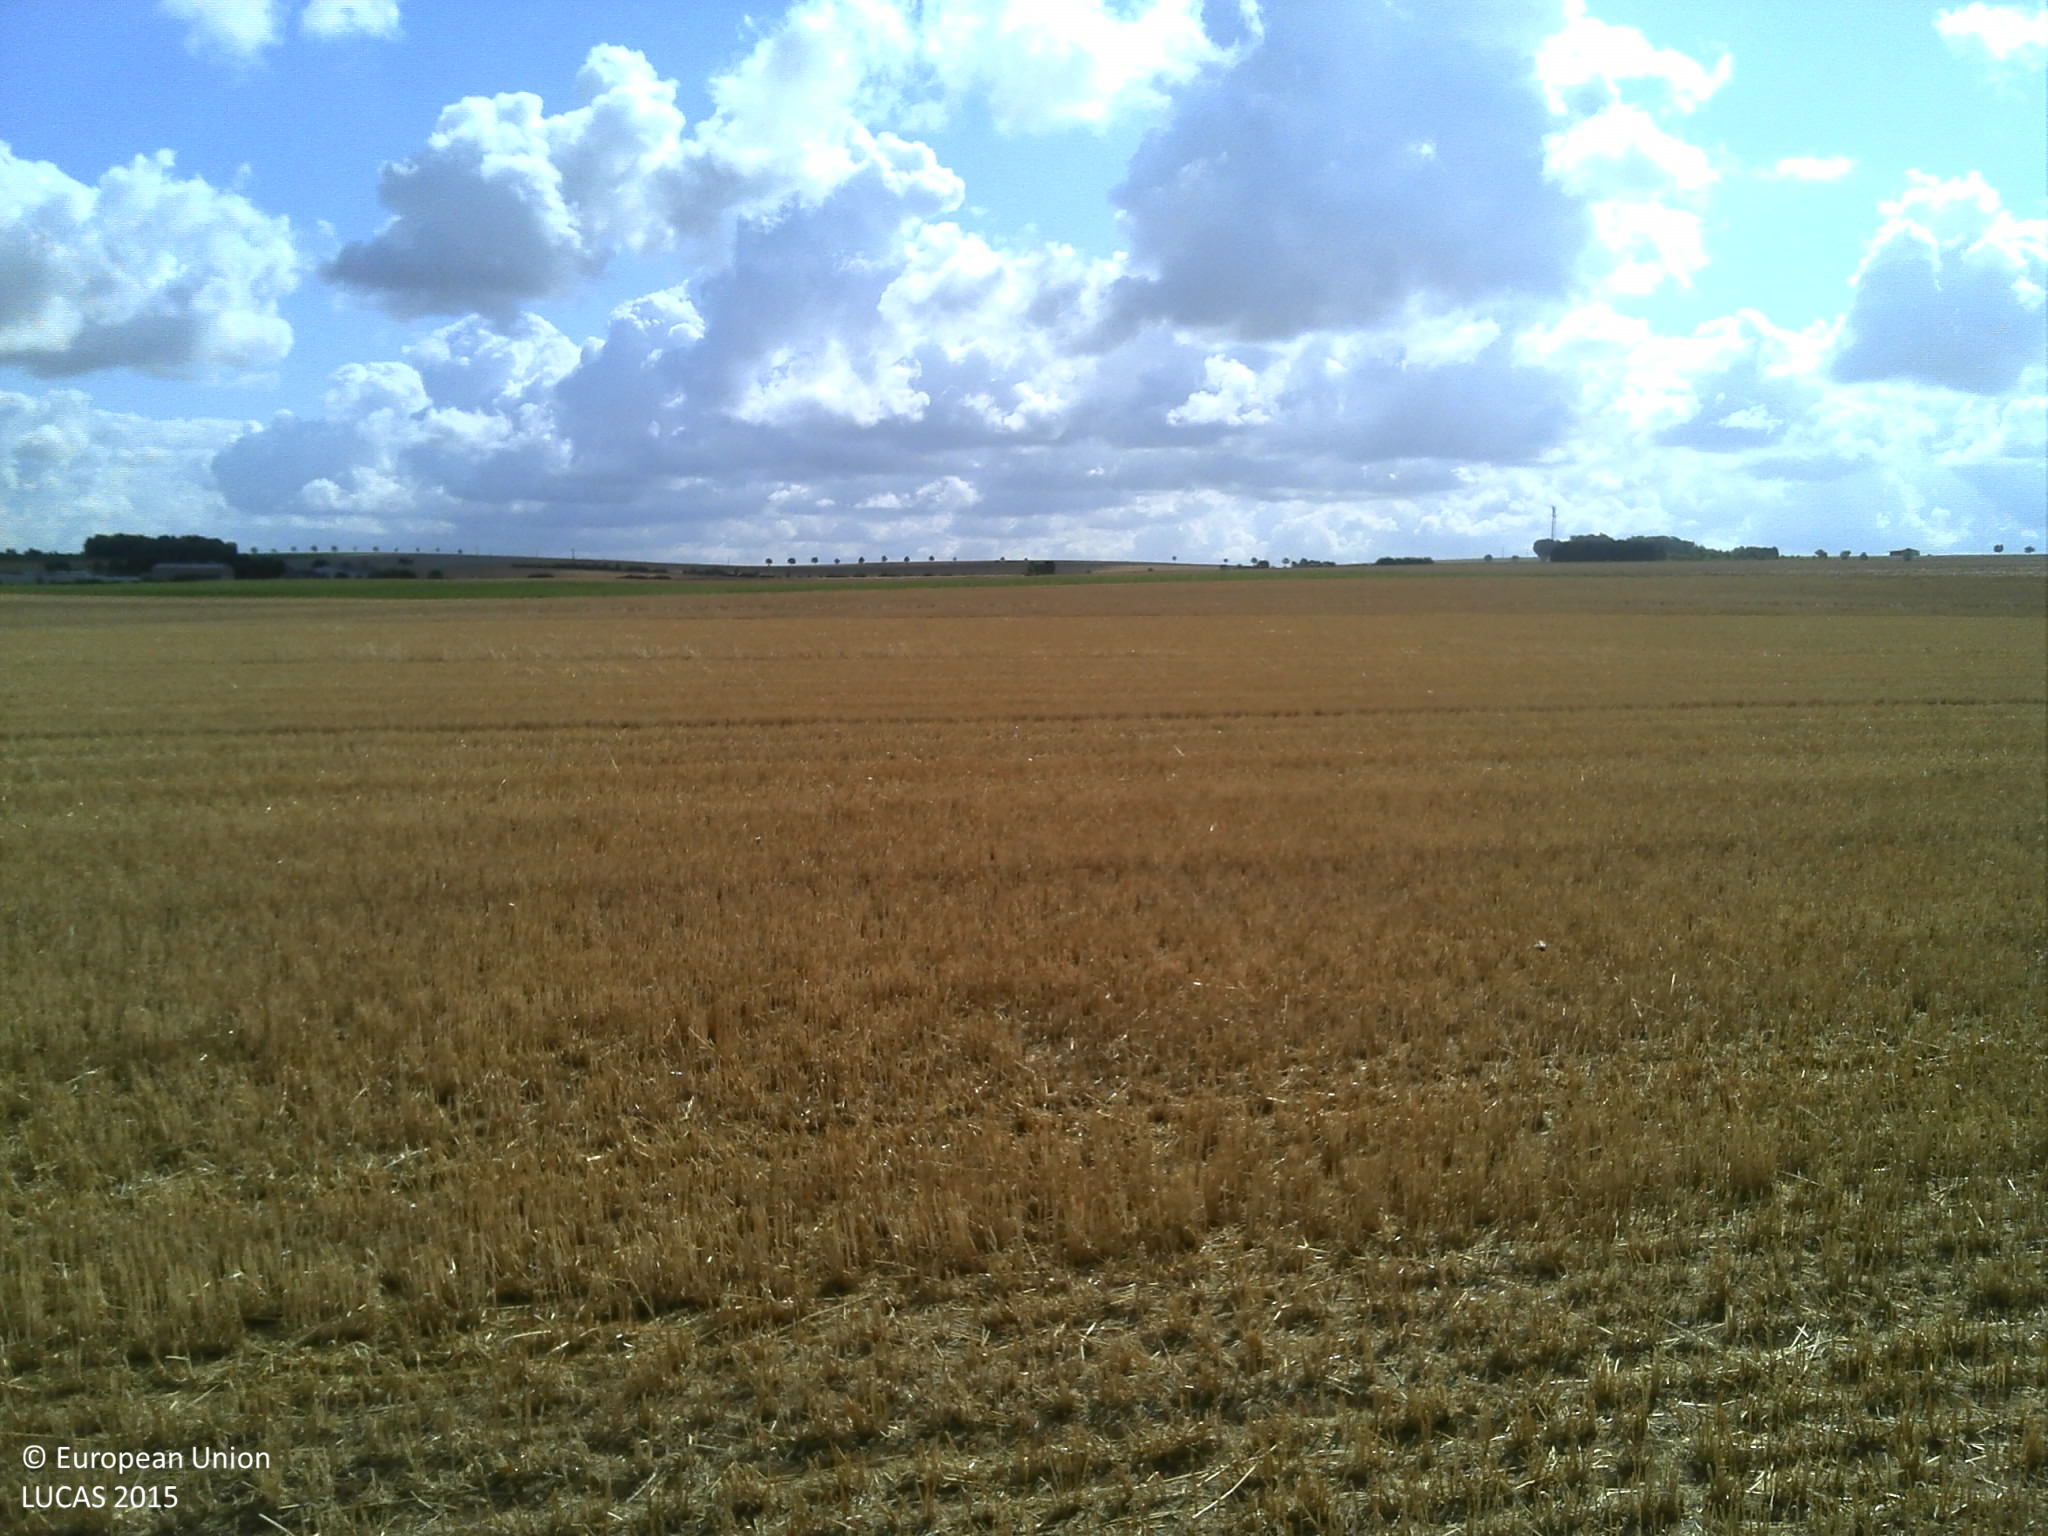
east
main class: Cropland
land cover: Barley
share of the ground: 50 - 75 %
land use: Agriculture (excluding fallow land and kitchen gardens)
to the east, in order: Barley; Common wheat
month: July
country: FR
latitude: 49.3142
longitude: 4.5354
